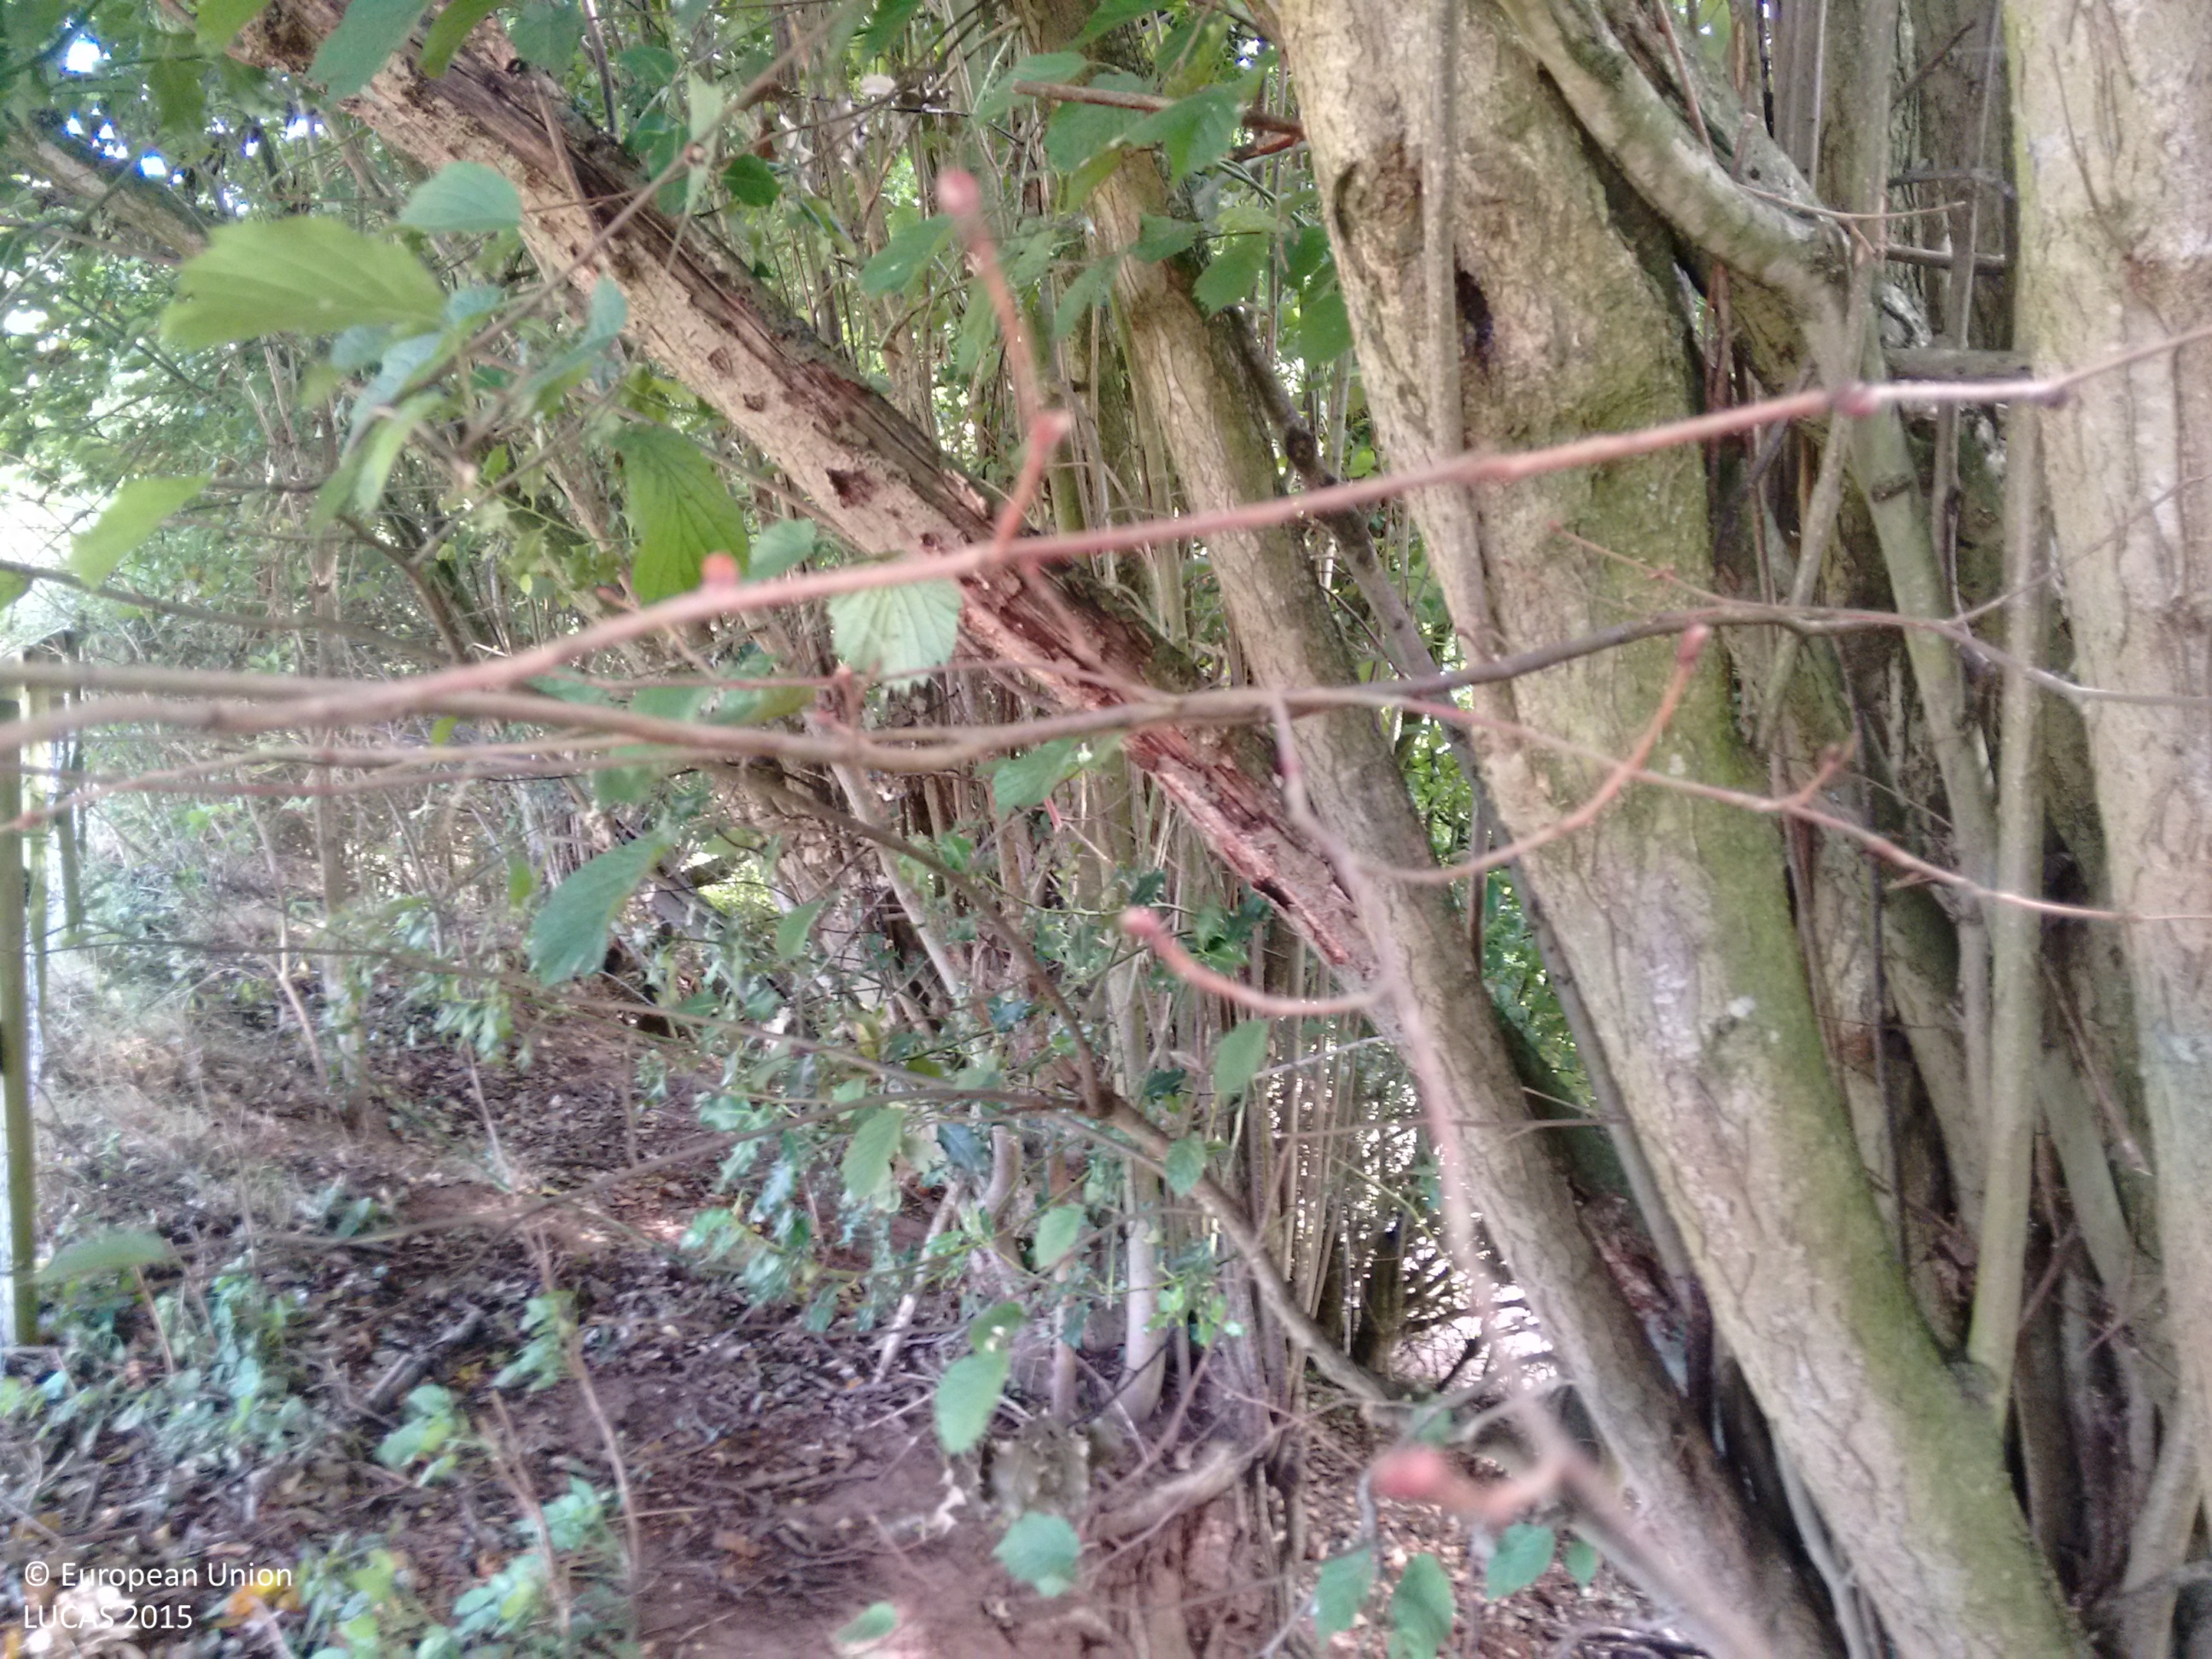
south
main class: Grassland
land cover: Grassland without tree/shrub cover
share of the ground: > 75 %
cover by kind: herbaceous plants 100 %
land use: Agriculture (excluding fallow land and kitchen gardens)
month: August
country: GB
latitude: 51.8924
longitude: -2.6972
